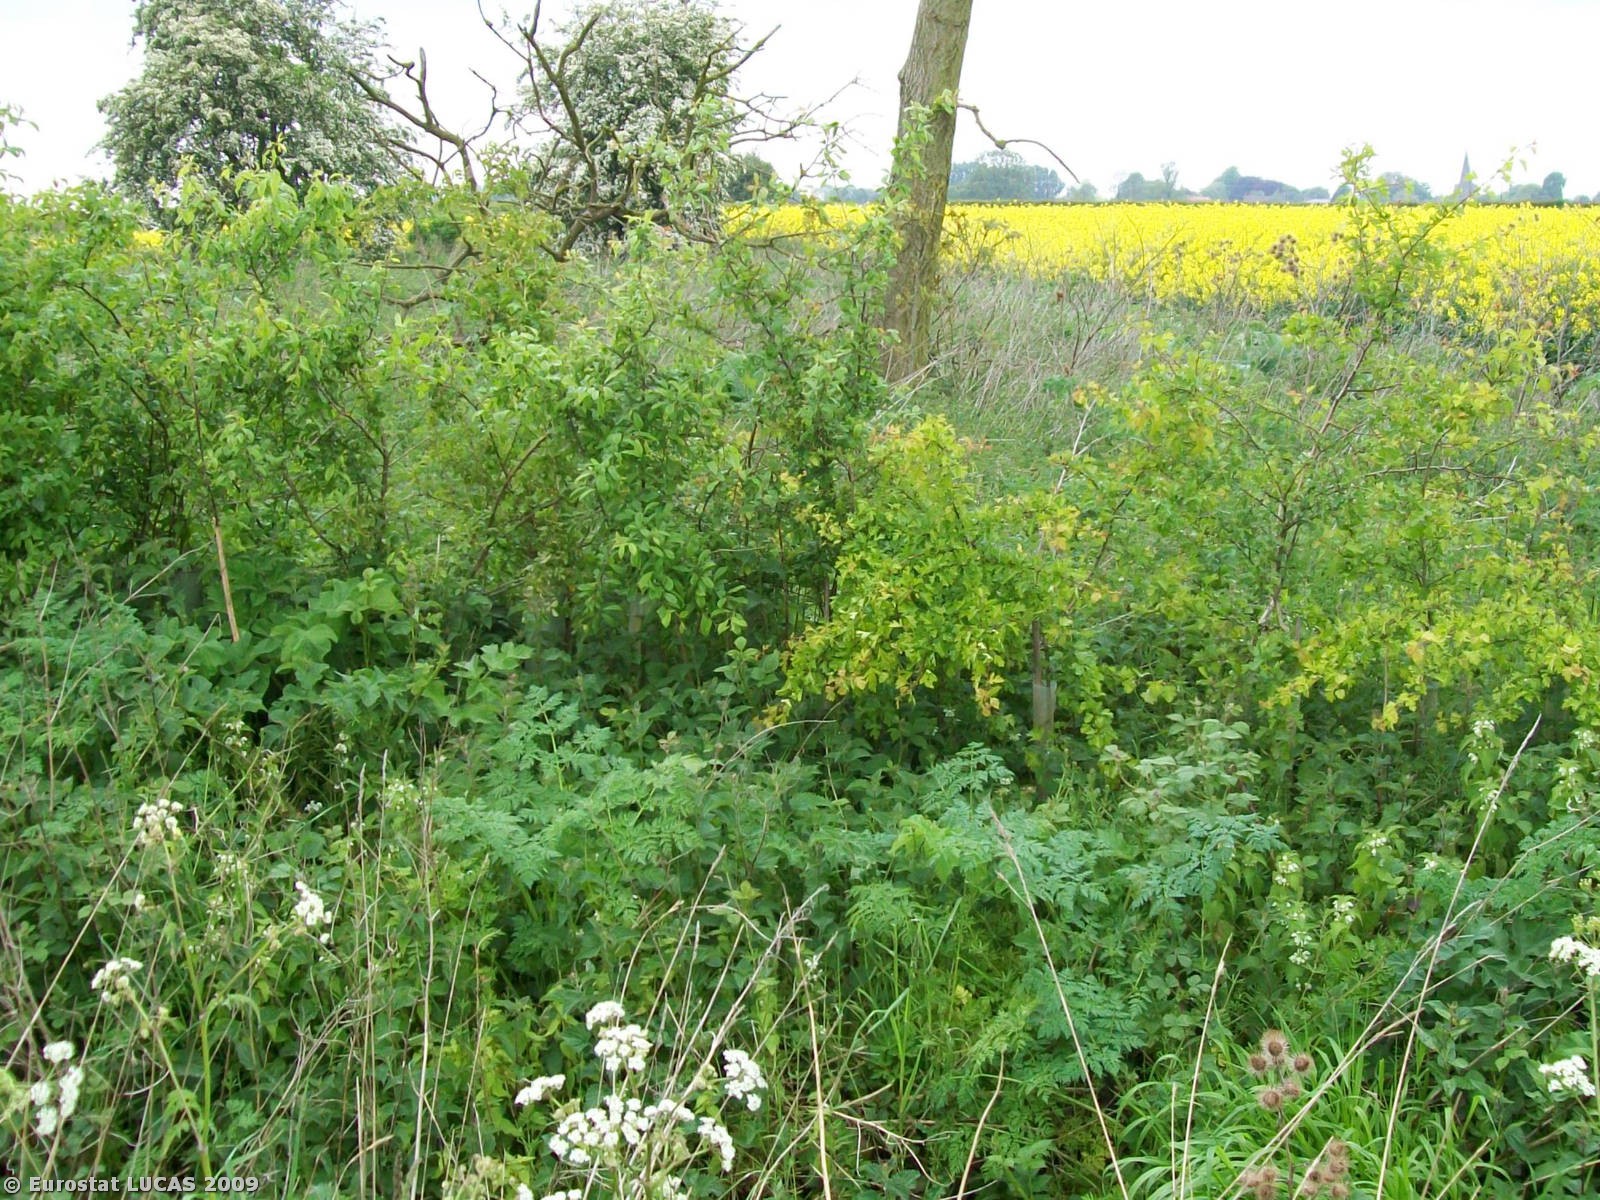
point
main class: Cropland
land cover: Common wheat
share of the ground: > 75 %
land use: Agriculture (excluding fallow land and kitchen gardens)
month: May
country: GB
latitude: 52.9277
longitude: -0.8869
